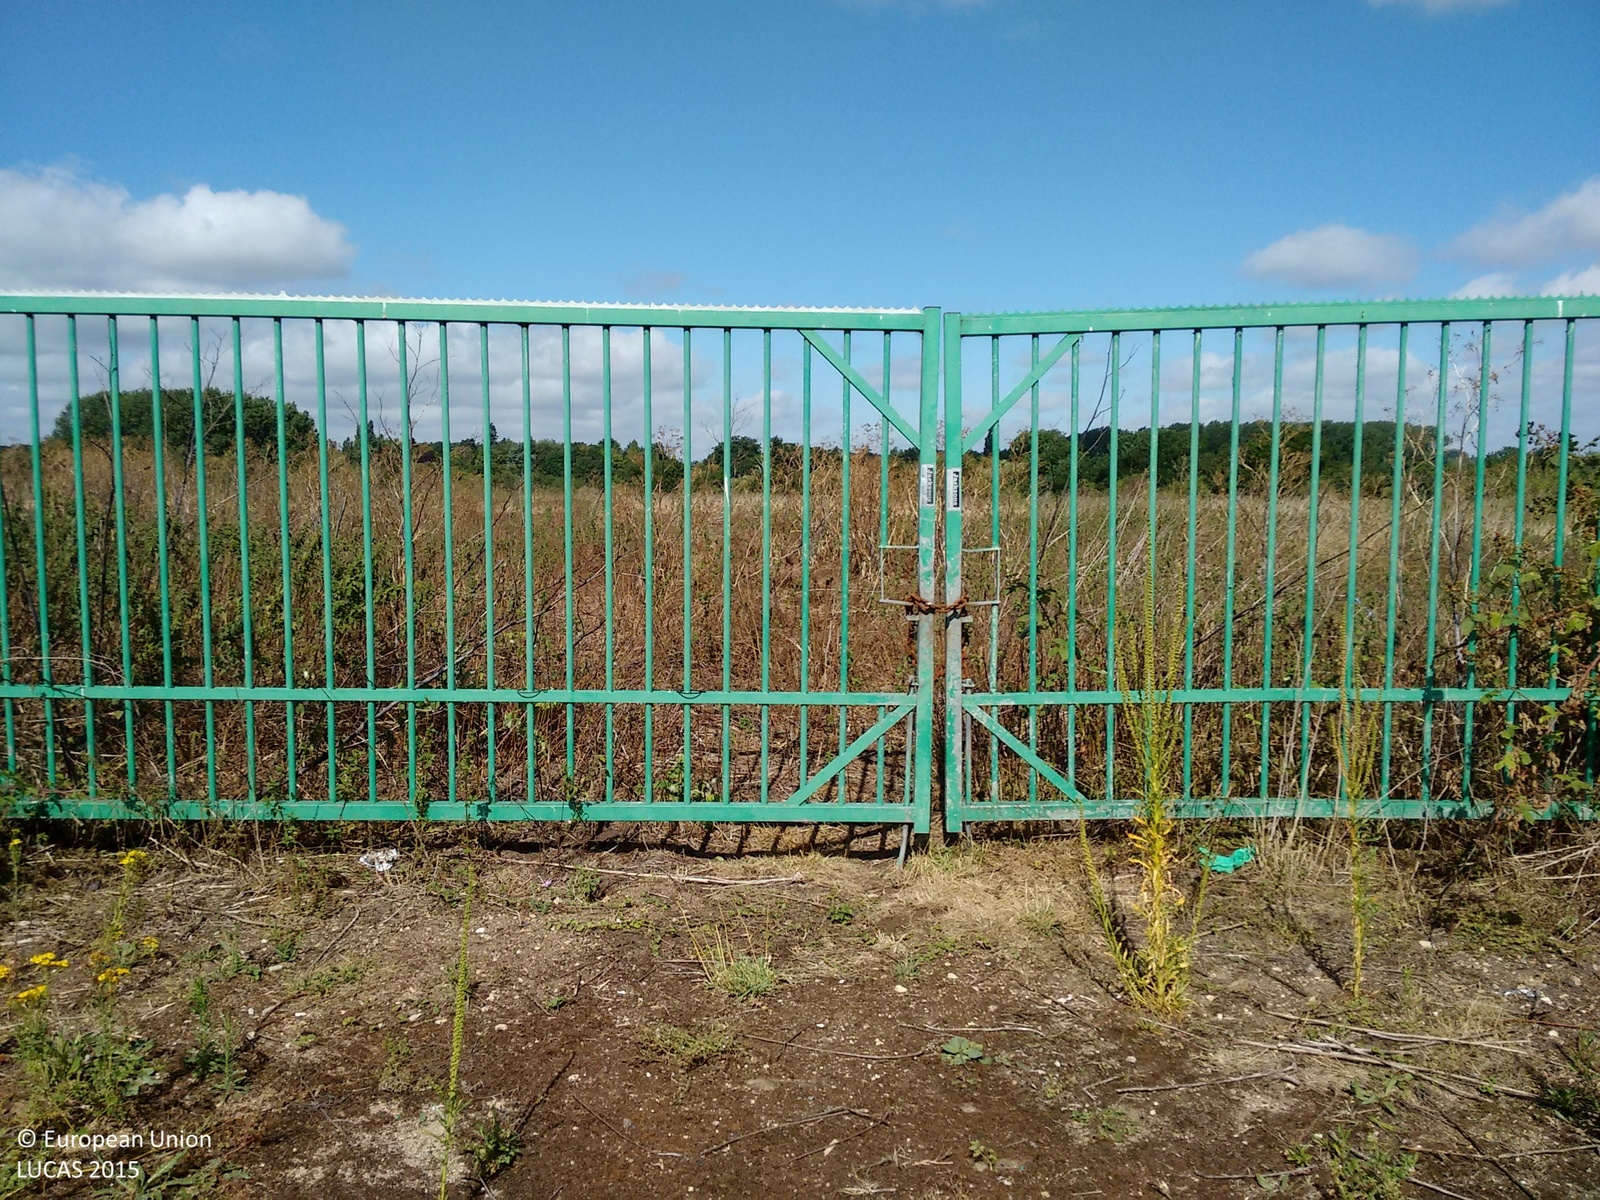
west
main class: Shrubland
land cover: Shrubland without tree cover
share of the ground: > 75 %
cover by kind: shrubs 50 %, herbaceous plants 40 %, consolidated bare surface 10 %
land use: Fallow land
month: July
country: GB
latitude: 51.3986
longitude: -0.5460
